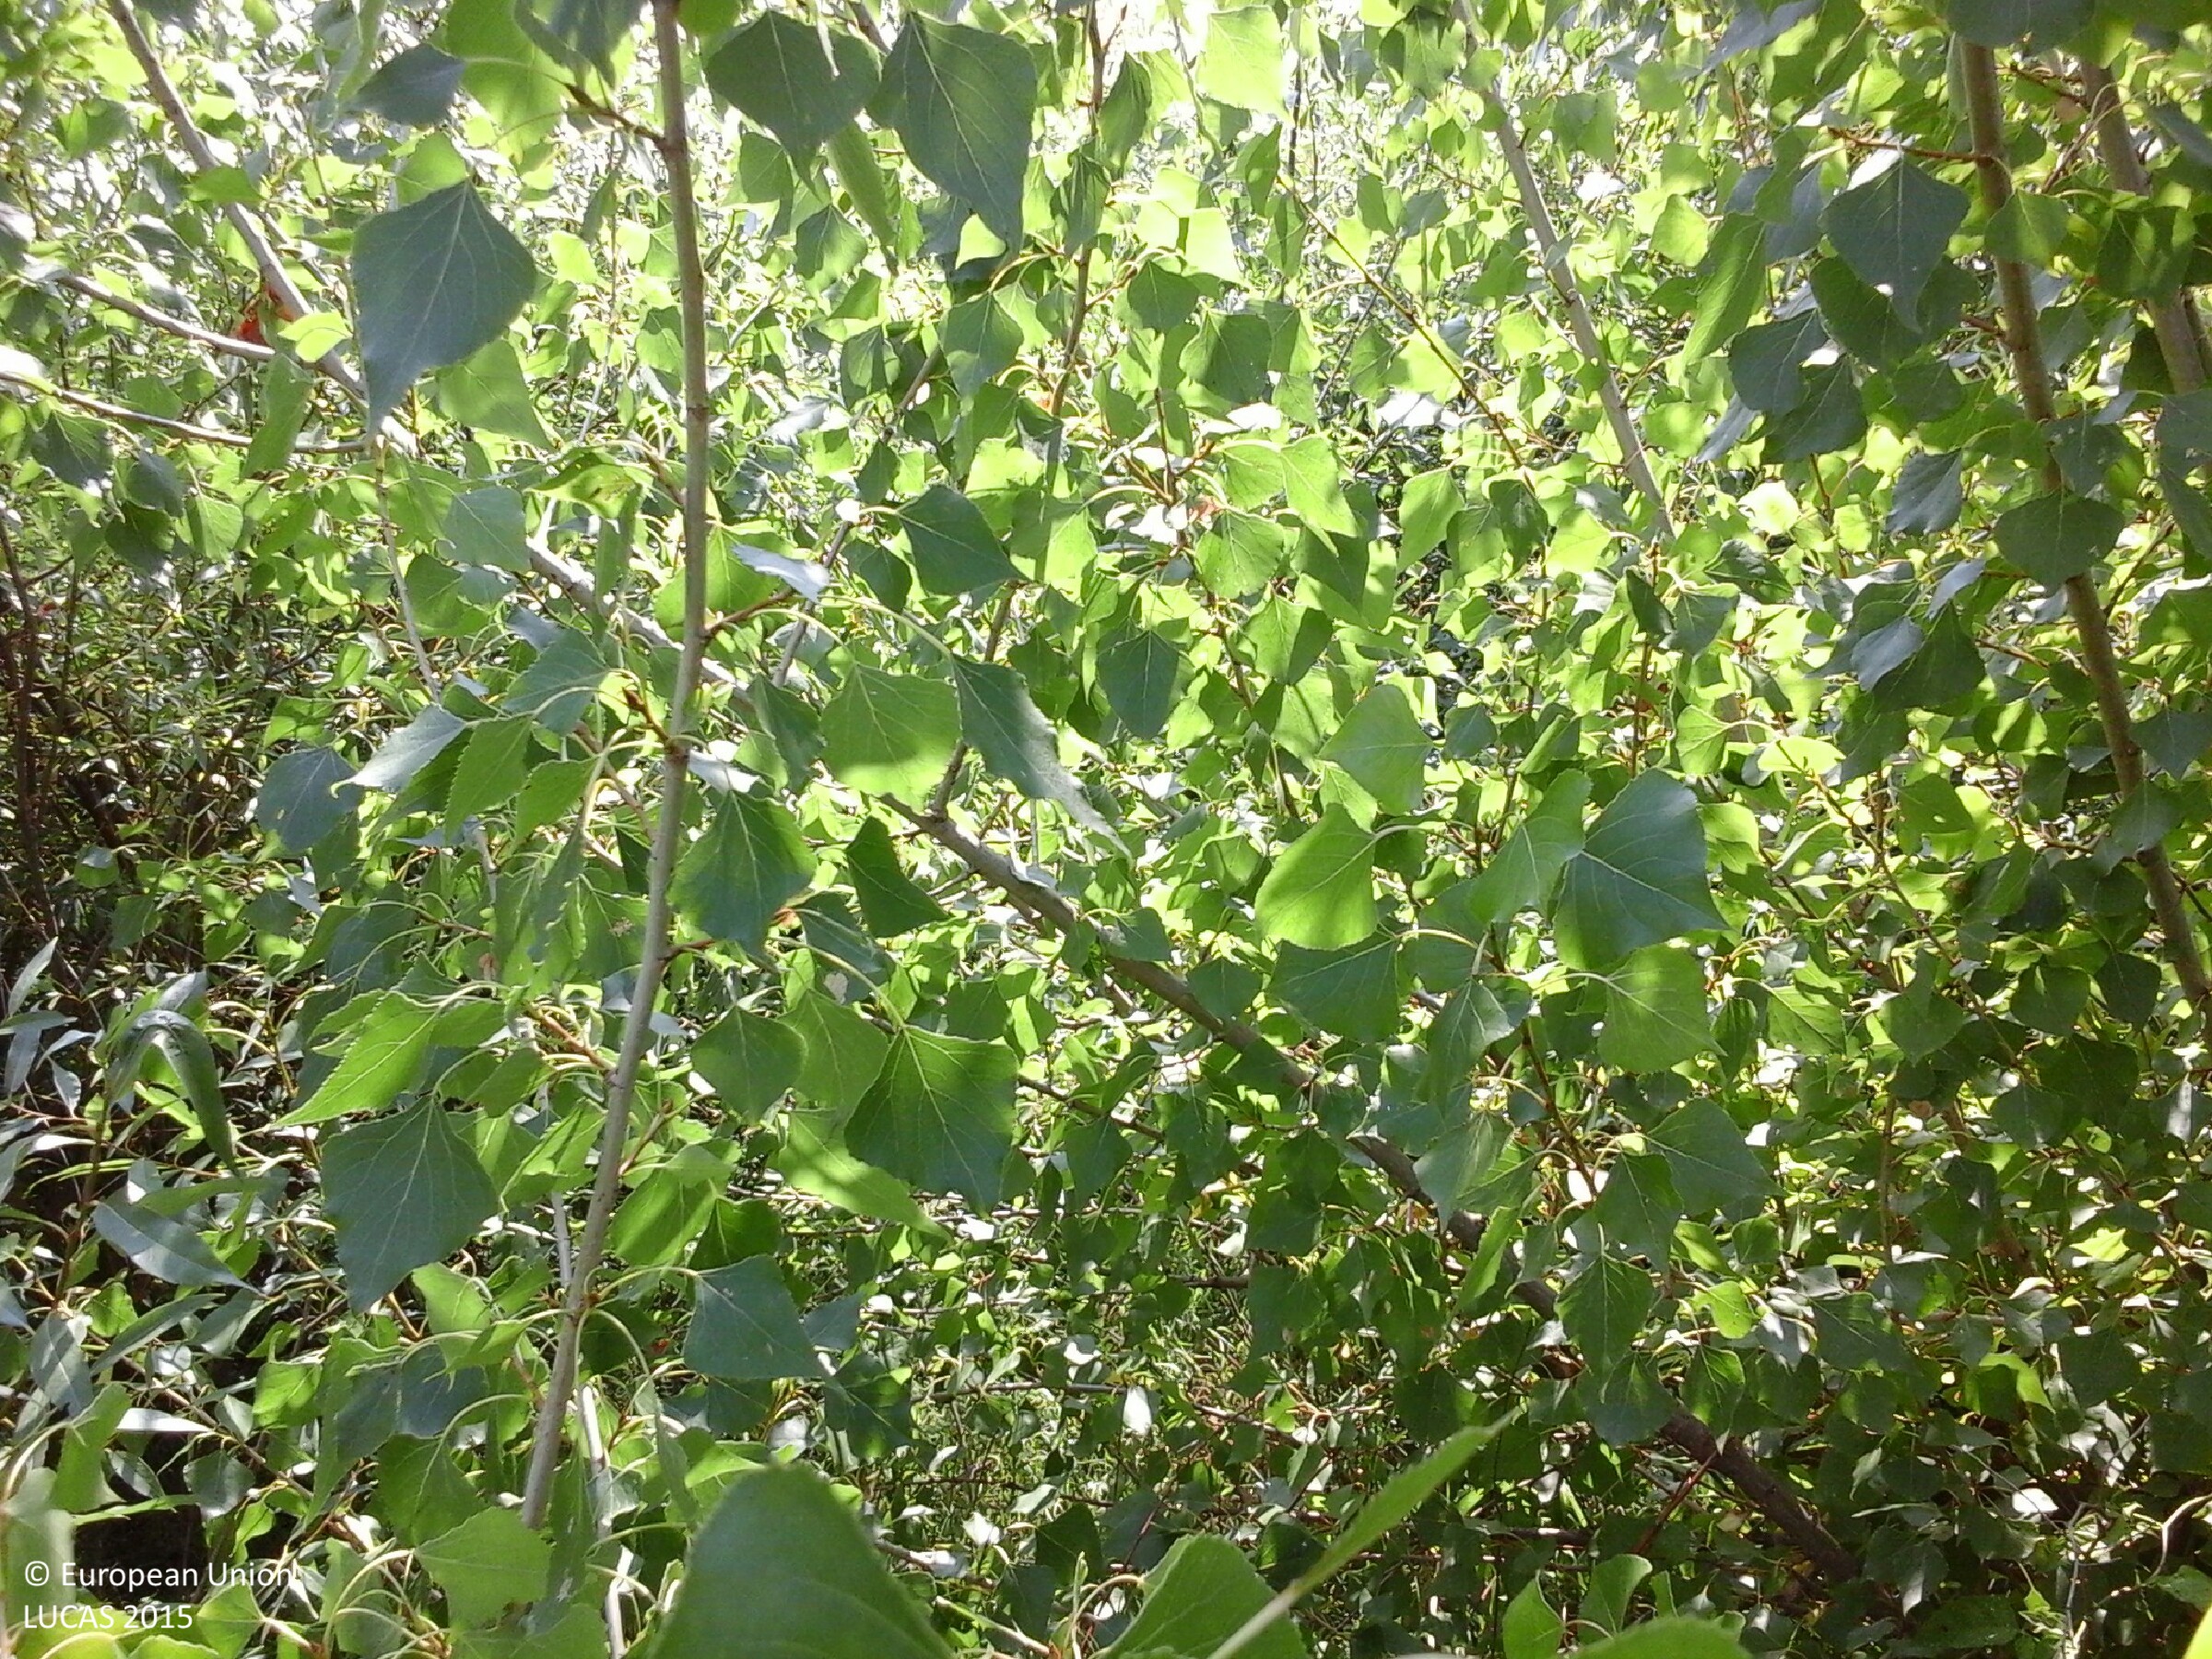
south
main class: Woodland
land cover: Broadleaved woodland
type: floodplain forest
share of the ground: 50 - 75 %
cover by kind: broadleaved forest trees 60 %, herbaceous plants 40 %
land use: Semi-natural and natural areas not in use
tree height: < 5 m
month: July
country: HU
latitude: 48.0455
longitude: 20.8899
